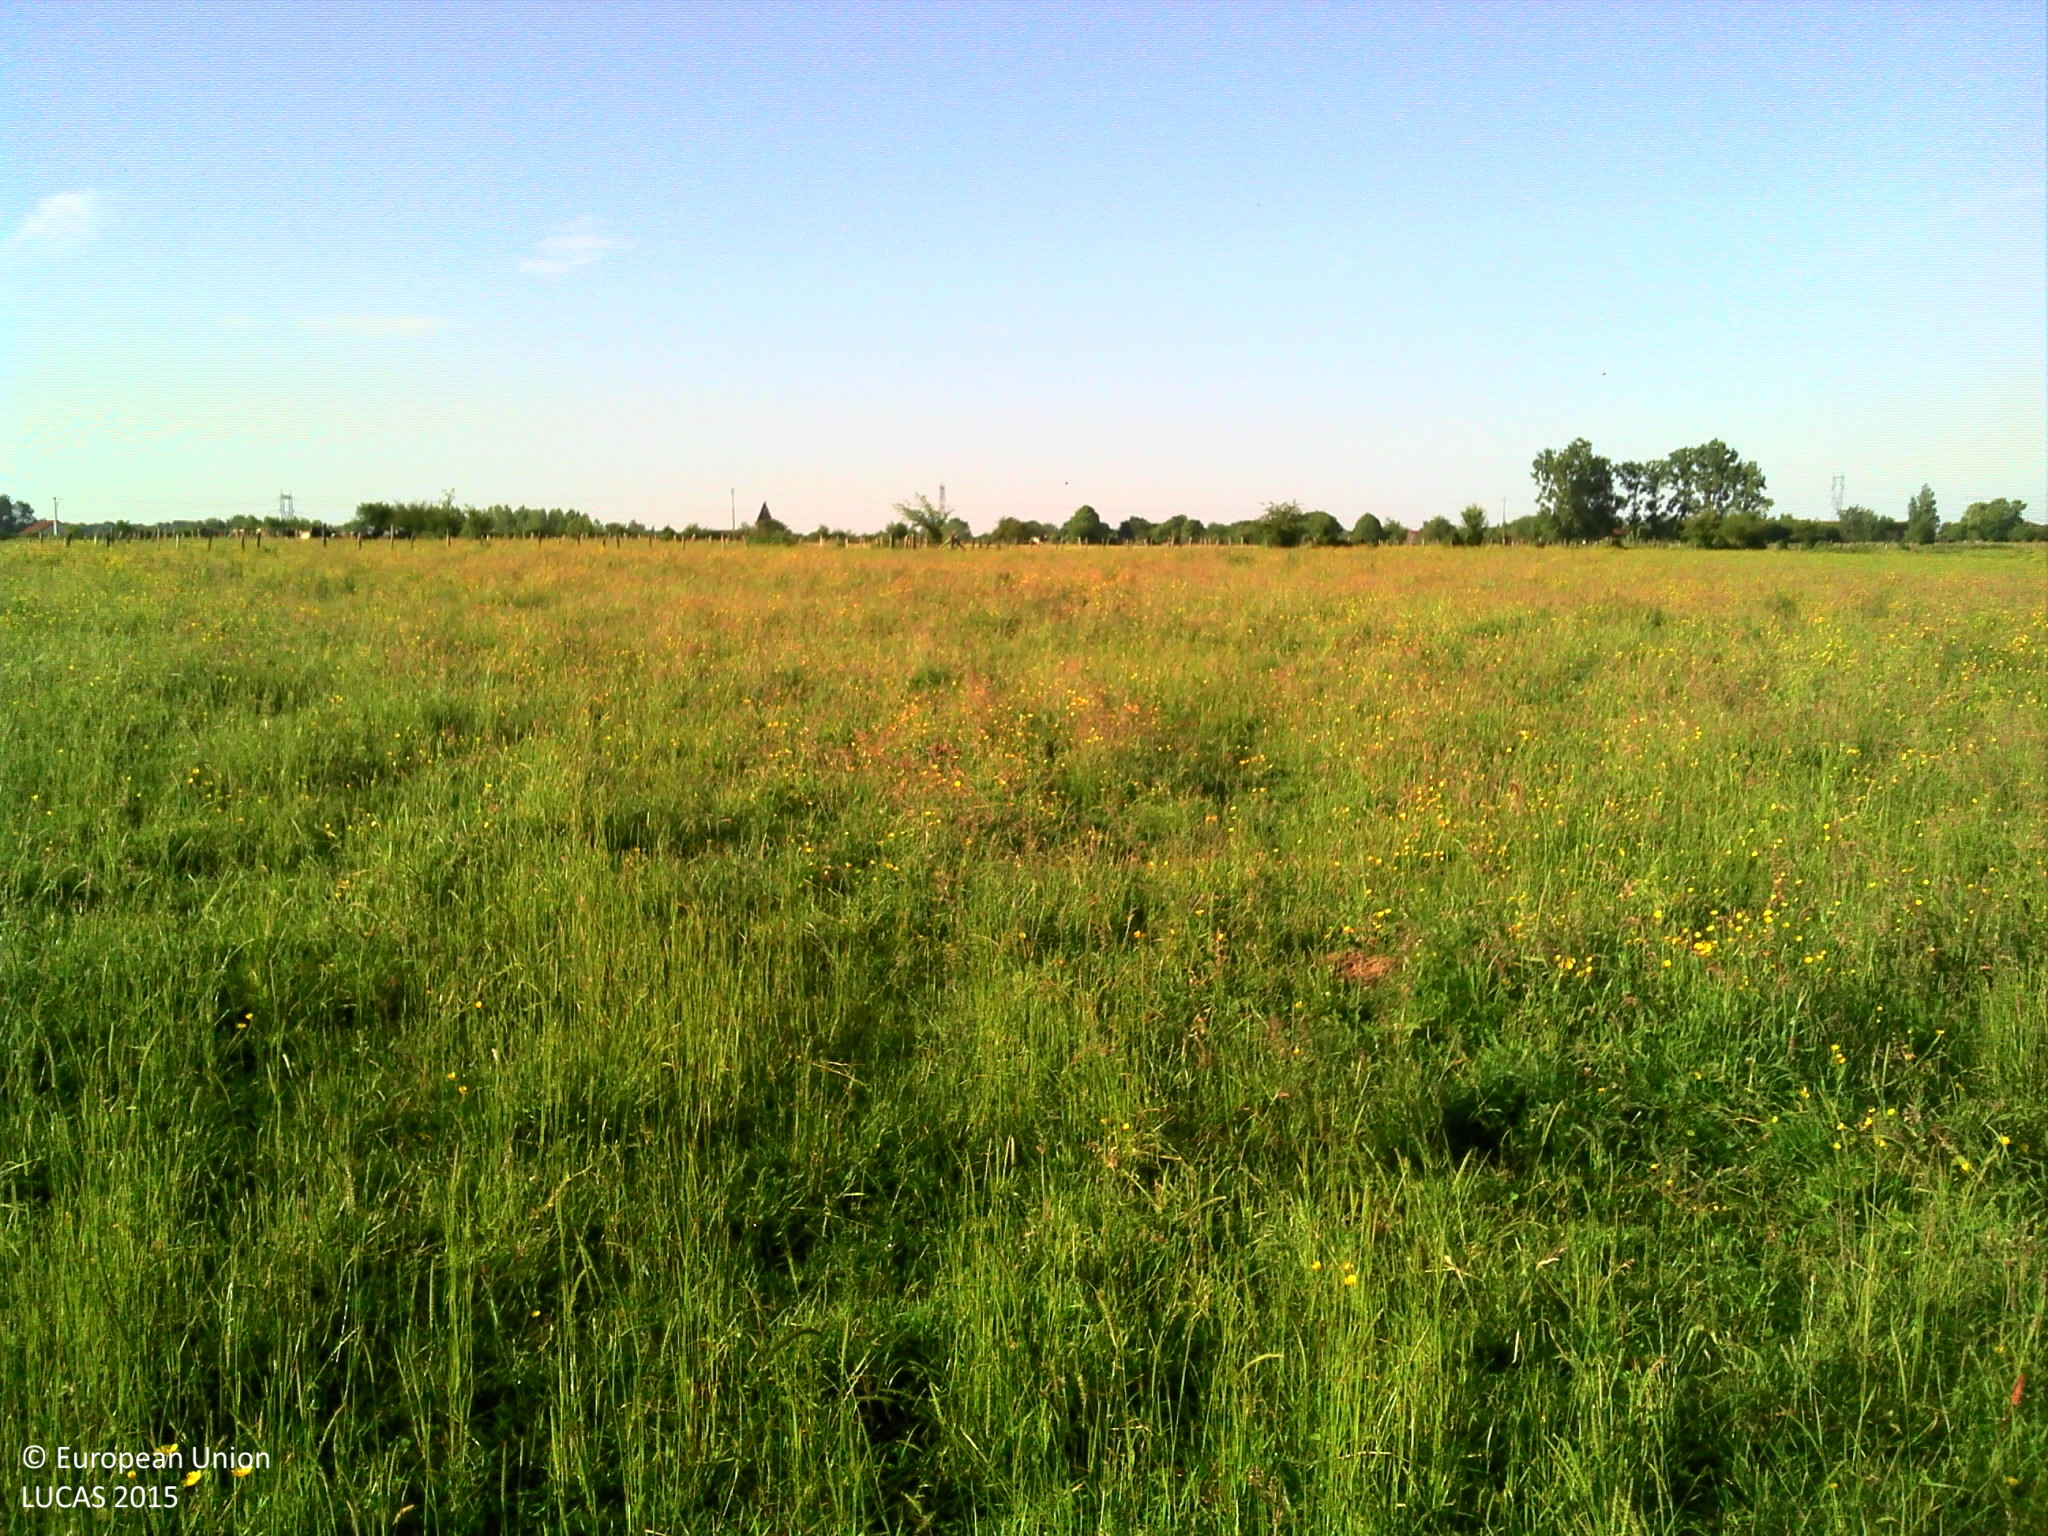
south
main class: Grassland
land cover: Grassland without tree/shrub cover
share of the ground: > 75 %
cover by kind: herbaceous plants 100 %
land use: Agriculture (excluding fallow land and kitchen gardens)
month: June
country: FR
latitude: 48.5149
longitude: 4.7859
